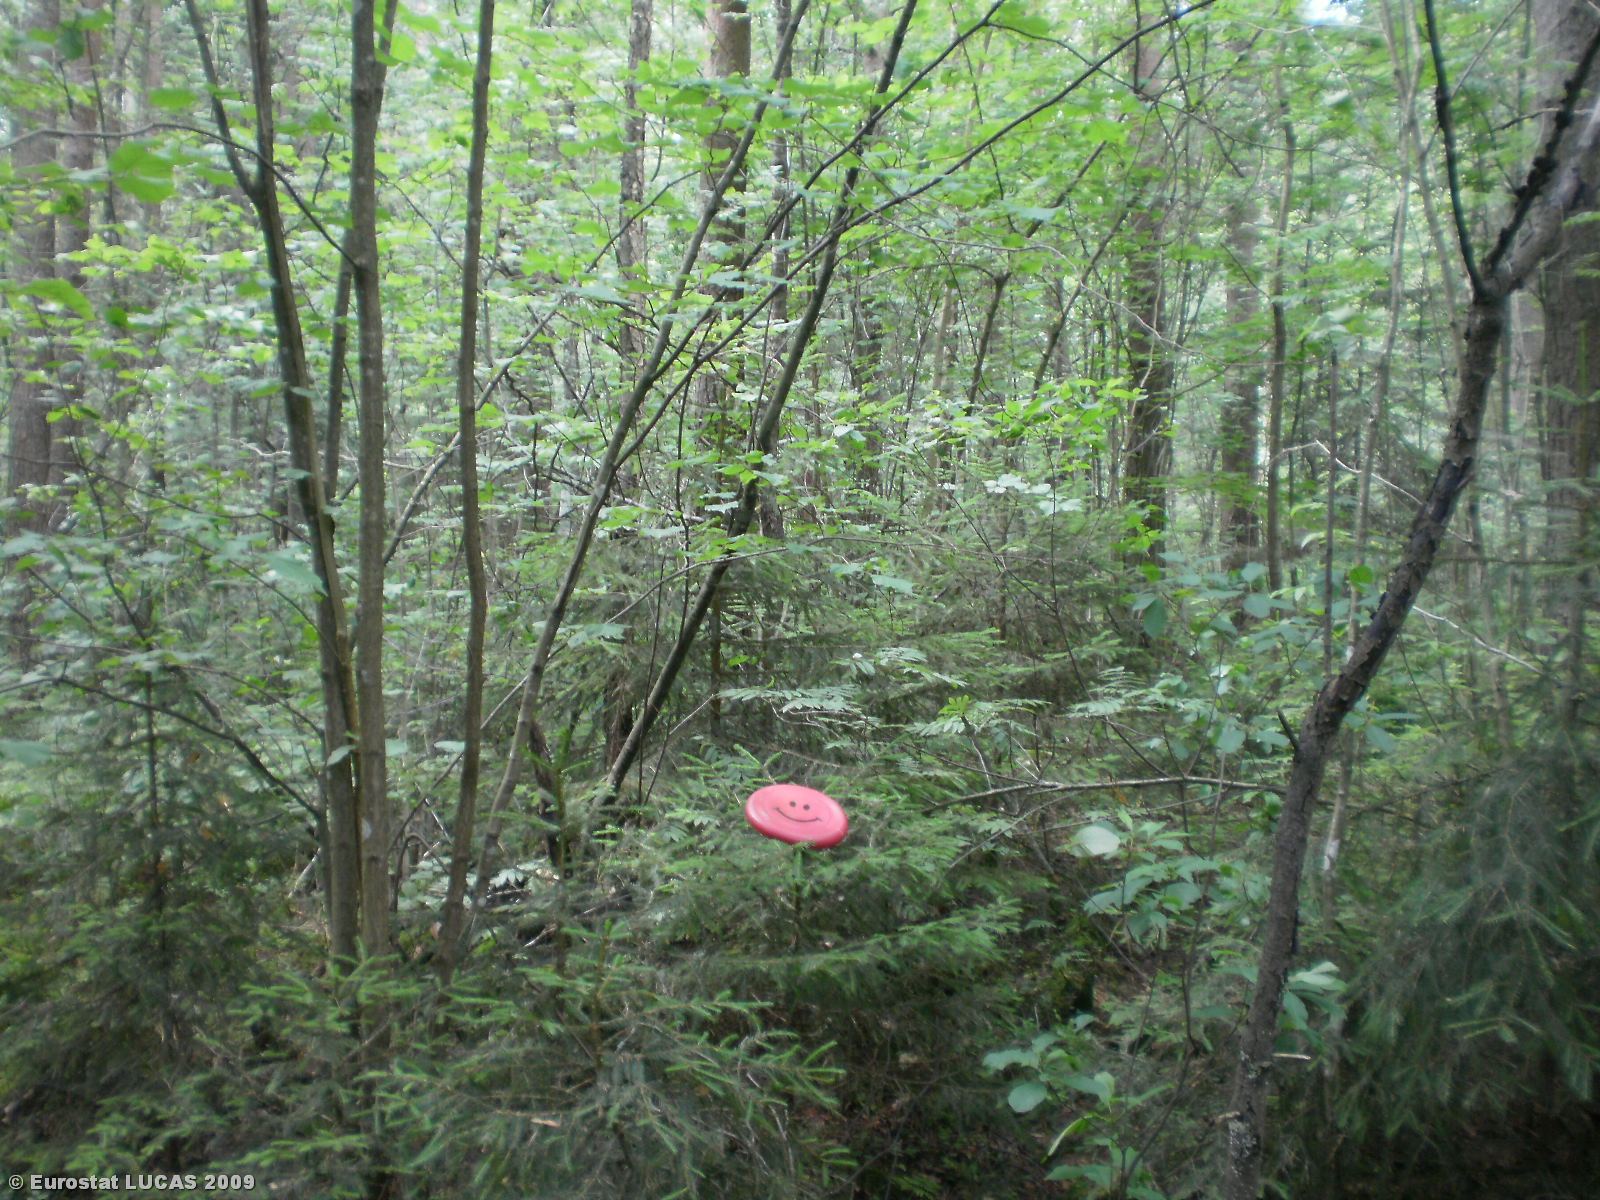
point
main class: Woodland
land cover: Coniferous woodland
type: boreal forest
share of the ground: 25 - 50 %
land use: Forestry
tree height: > 5 m
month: July
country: LT
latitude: 56.0110
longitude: 25.1750
